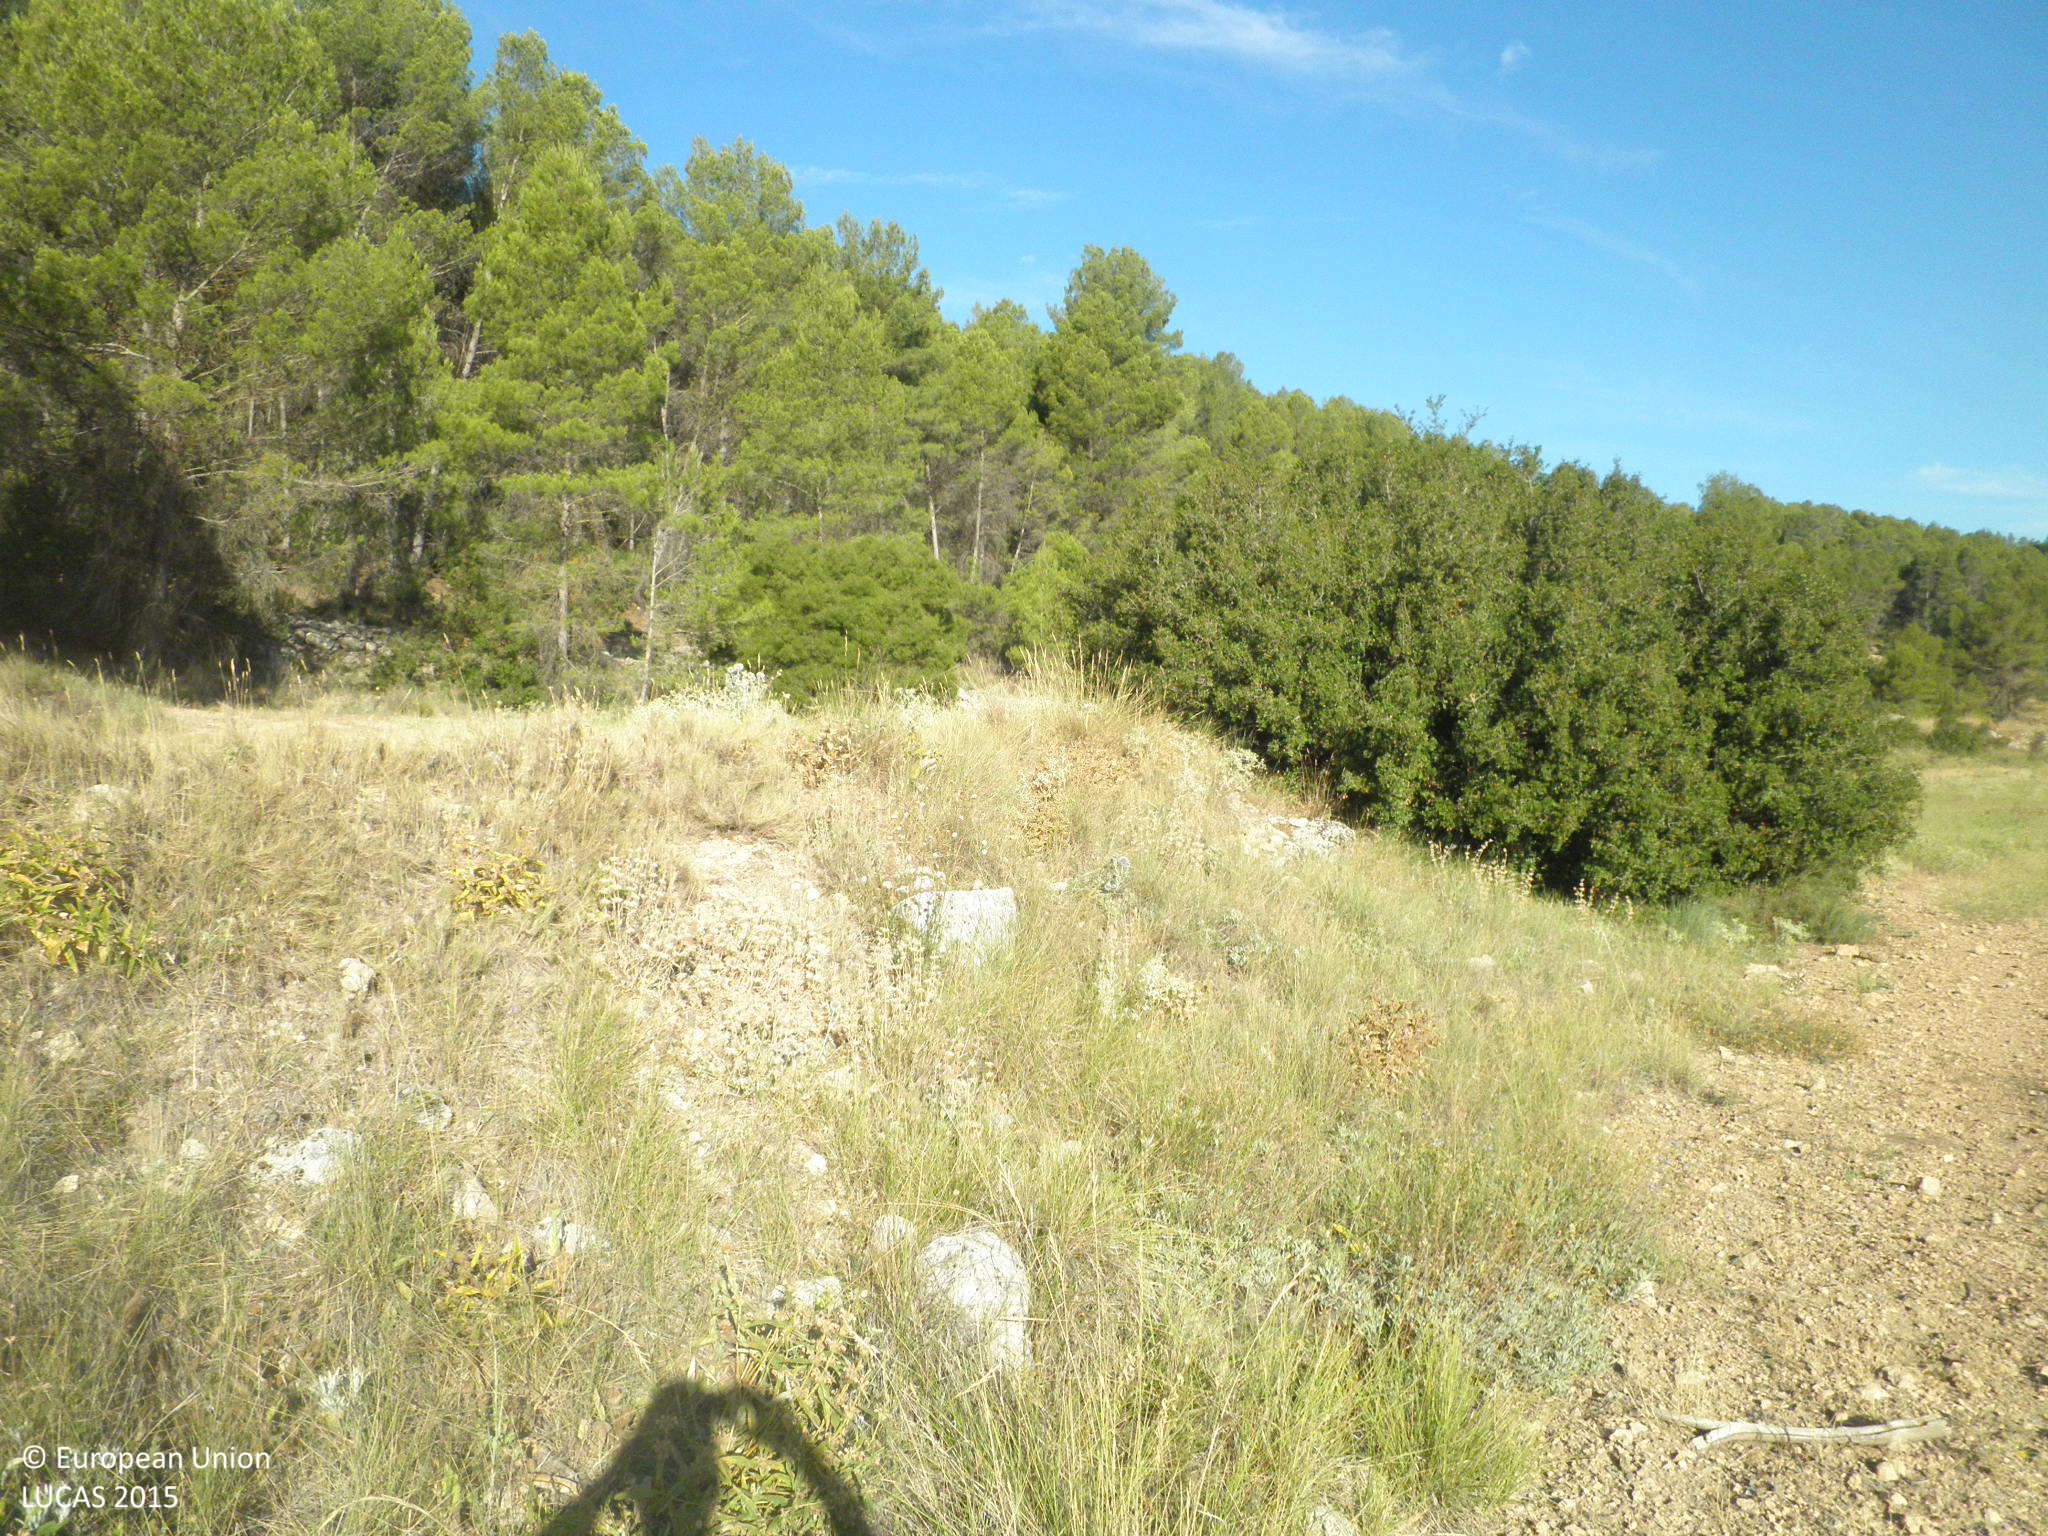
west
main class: Grassland
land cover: Grassland with sparse tree/shrub cover
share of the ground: > 75 %
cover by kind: herbaceous plants 75 %, unconsolidated bare surface 15 %, coniferous forest trees 5 %, shrubs 5 %
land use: Semi-natural and natural areas not in use
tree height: > 5 m
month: July
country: ES
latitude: 39.4680
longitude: -1.5930
